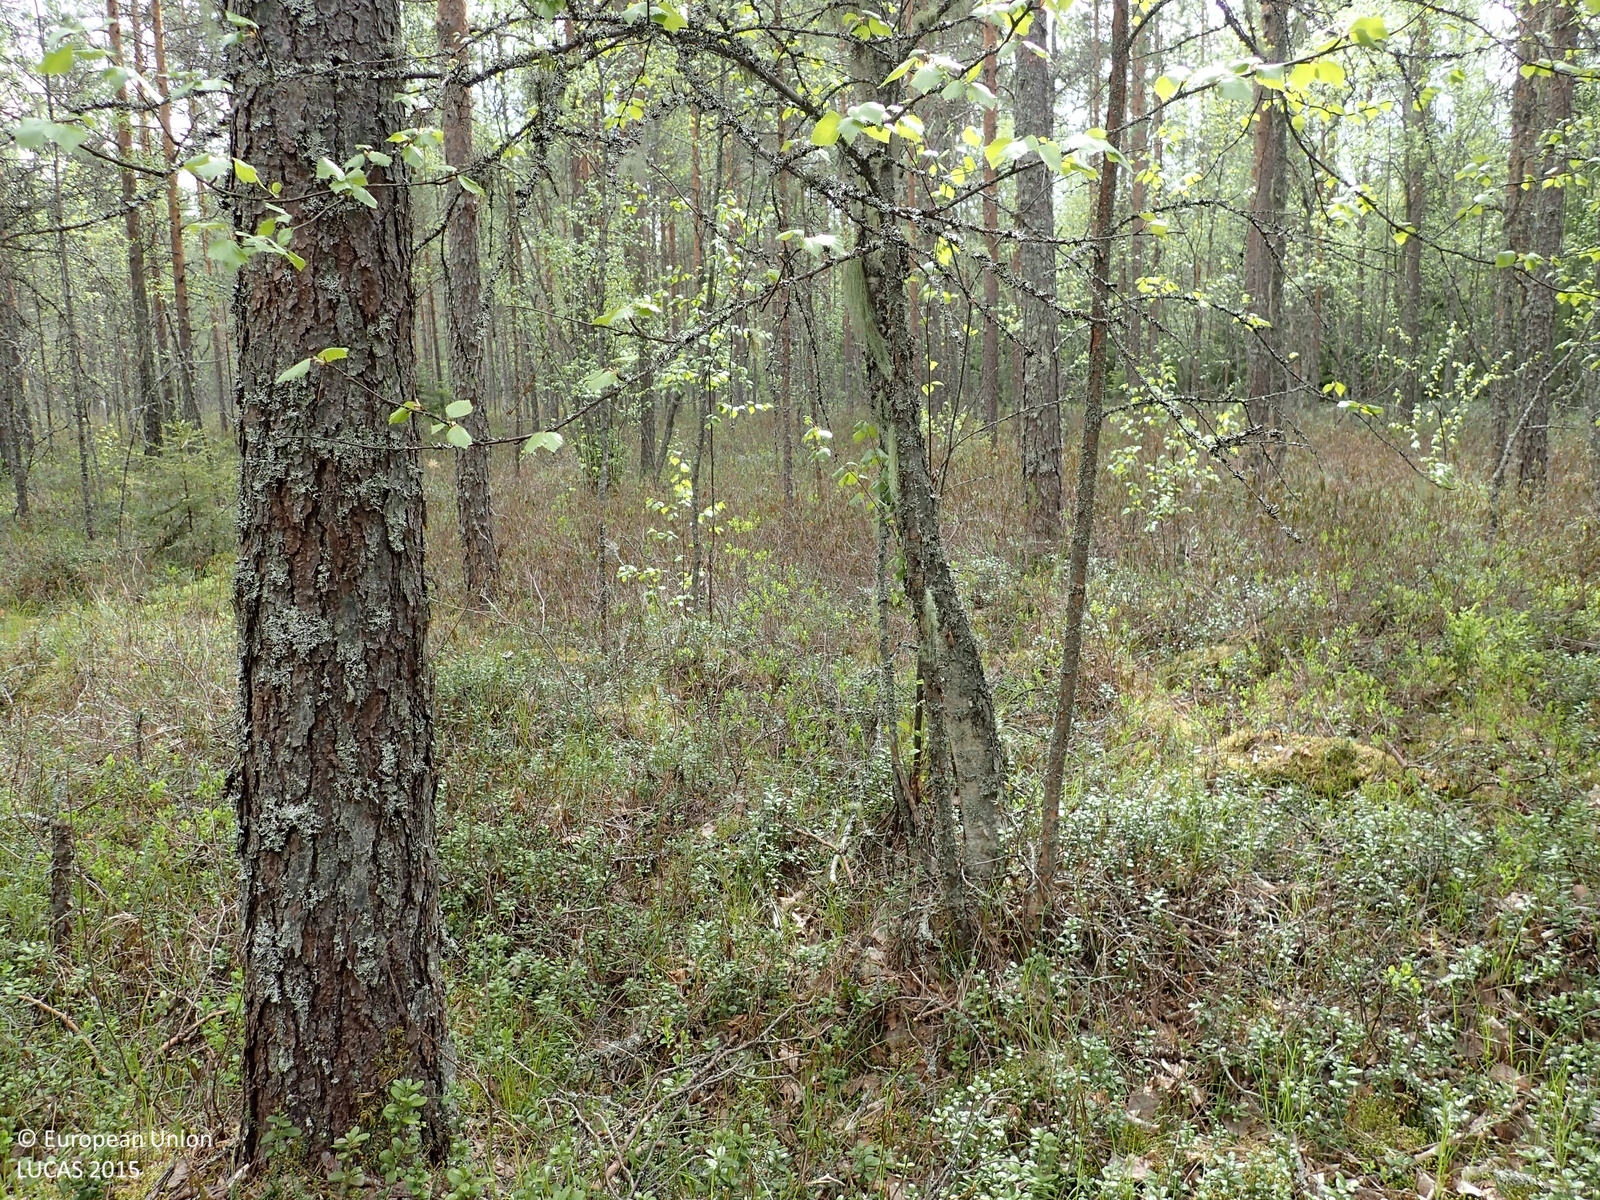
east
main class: Woodland
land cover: Pine dominated mixed woodland
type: boreal forest
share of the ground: > 75 %
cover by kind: coniferous forest trees 65 %, broadleaved forest trees 25 %, shrubs 10 %
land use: Forestry
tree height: > 5 m
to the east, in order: Pine dominated mixed woodland; Ditches and canals; Pine dominated coniferous woodland; Ditches and canals; Pine dominated coniferous woodland
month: June
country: FI
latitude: 62.2435
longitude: 21.7311
